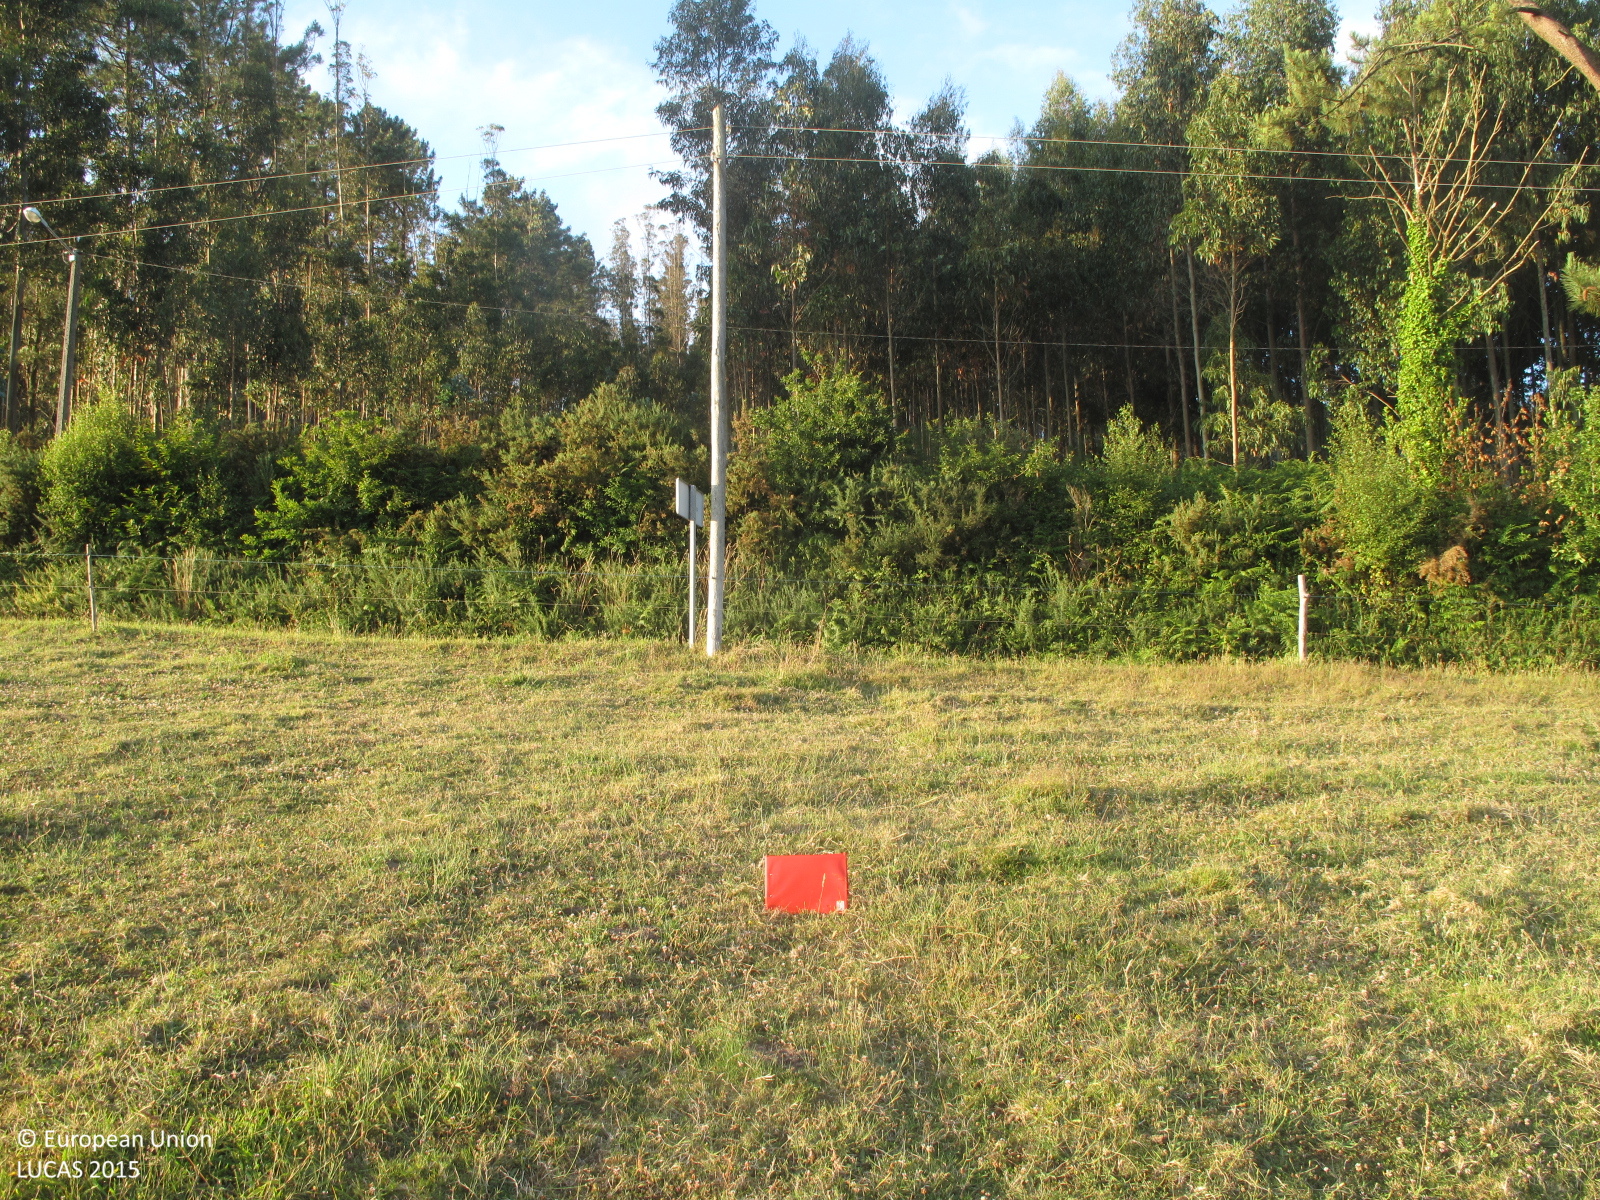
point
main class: Grassland
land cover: Grassland without tree/shrub cover
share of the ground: > 75 %
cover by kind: herbaceous plants 100 %
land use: Agriculture (excluding fallow land and kitchen gardens)
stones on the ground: 10 - 25 %
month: July
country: ES
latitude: 43.5611
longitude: -8.0620
